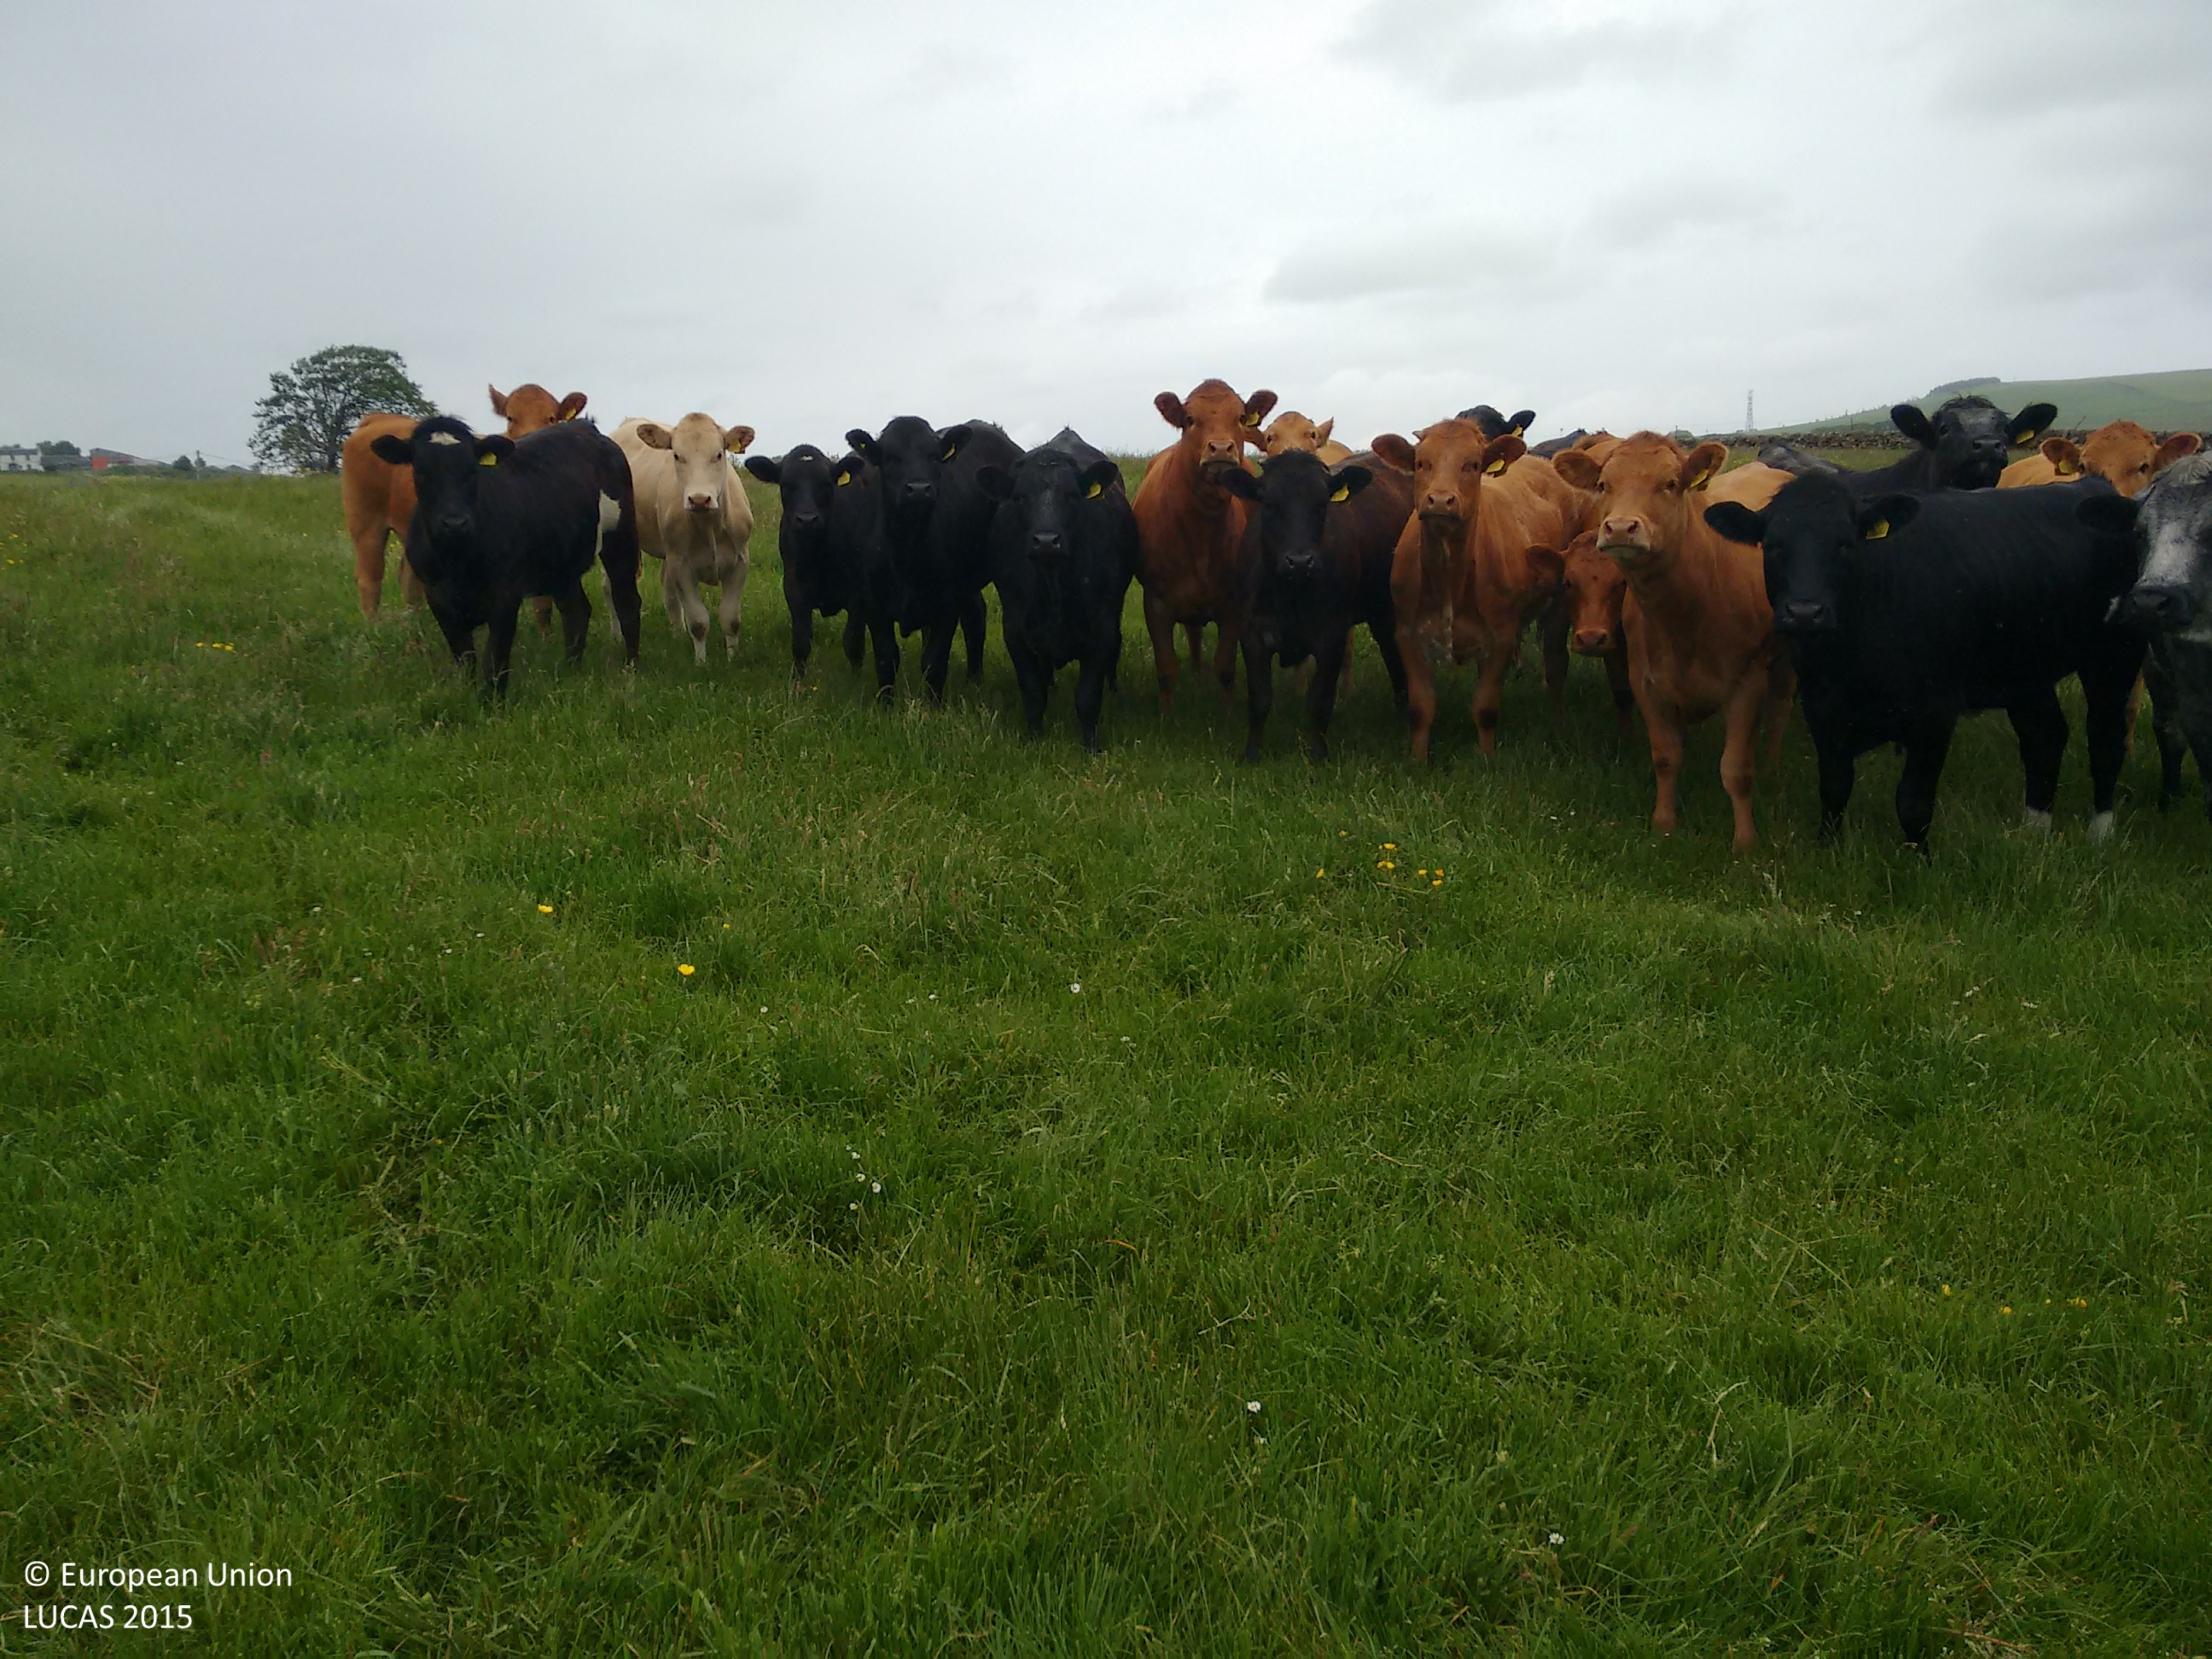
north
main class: Grassland
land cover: Grassland without tree/shrub cover
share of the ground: > 75 %
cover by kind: herbaceous plants 100 %
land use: Agriculture (excluding fallow land and kitchen gardens)
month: June
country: GB
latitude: 55.6319
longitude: -3.8571
